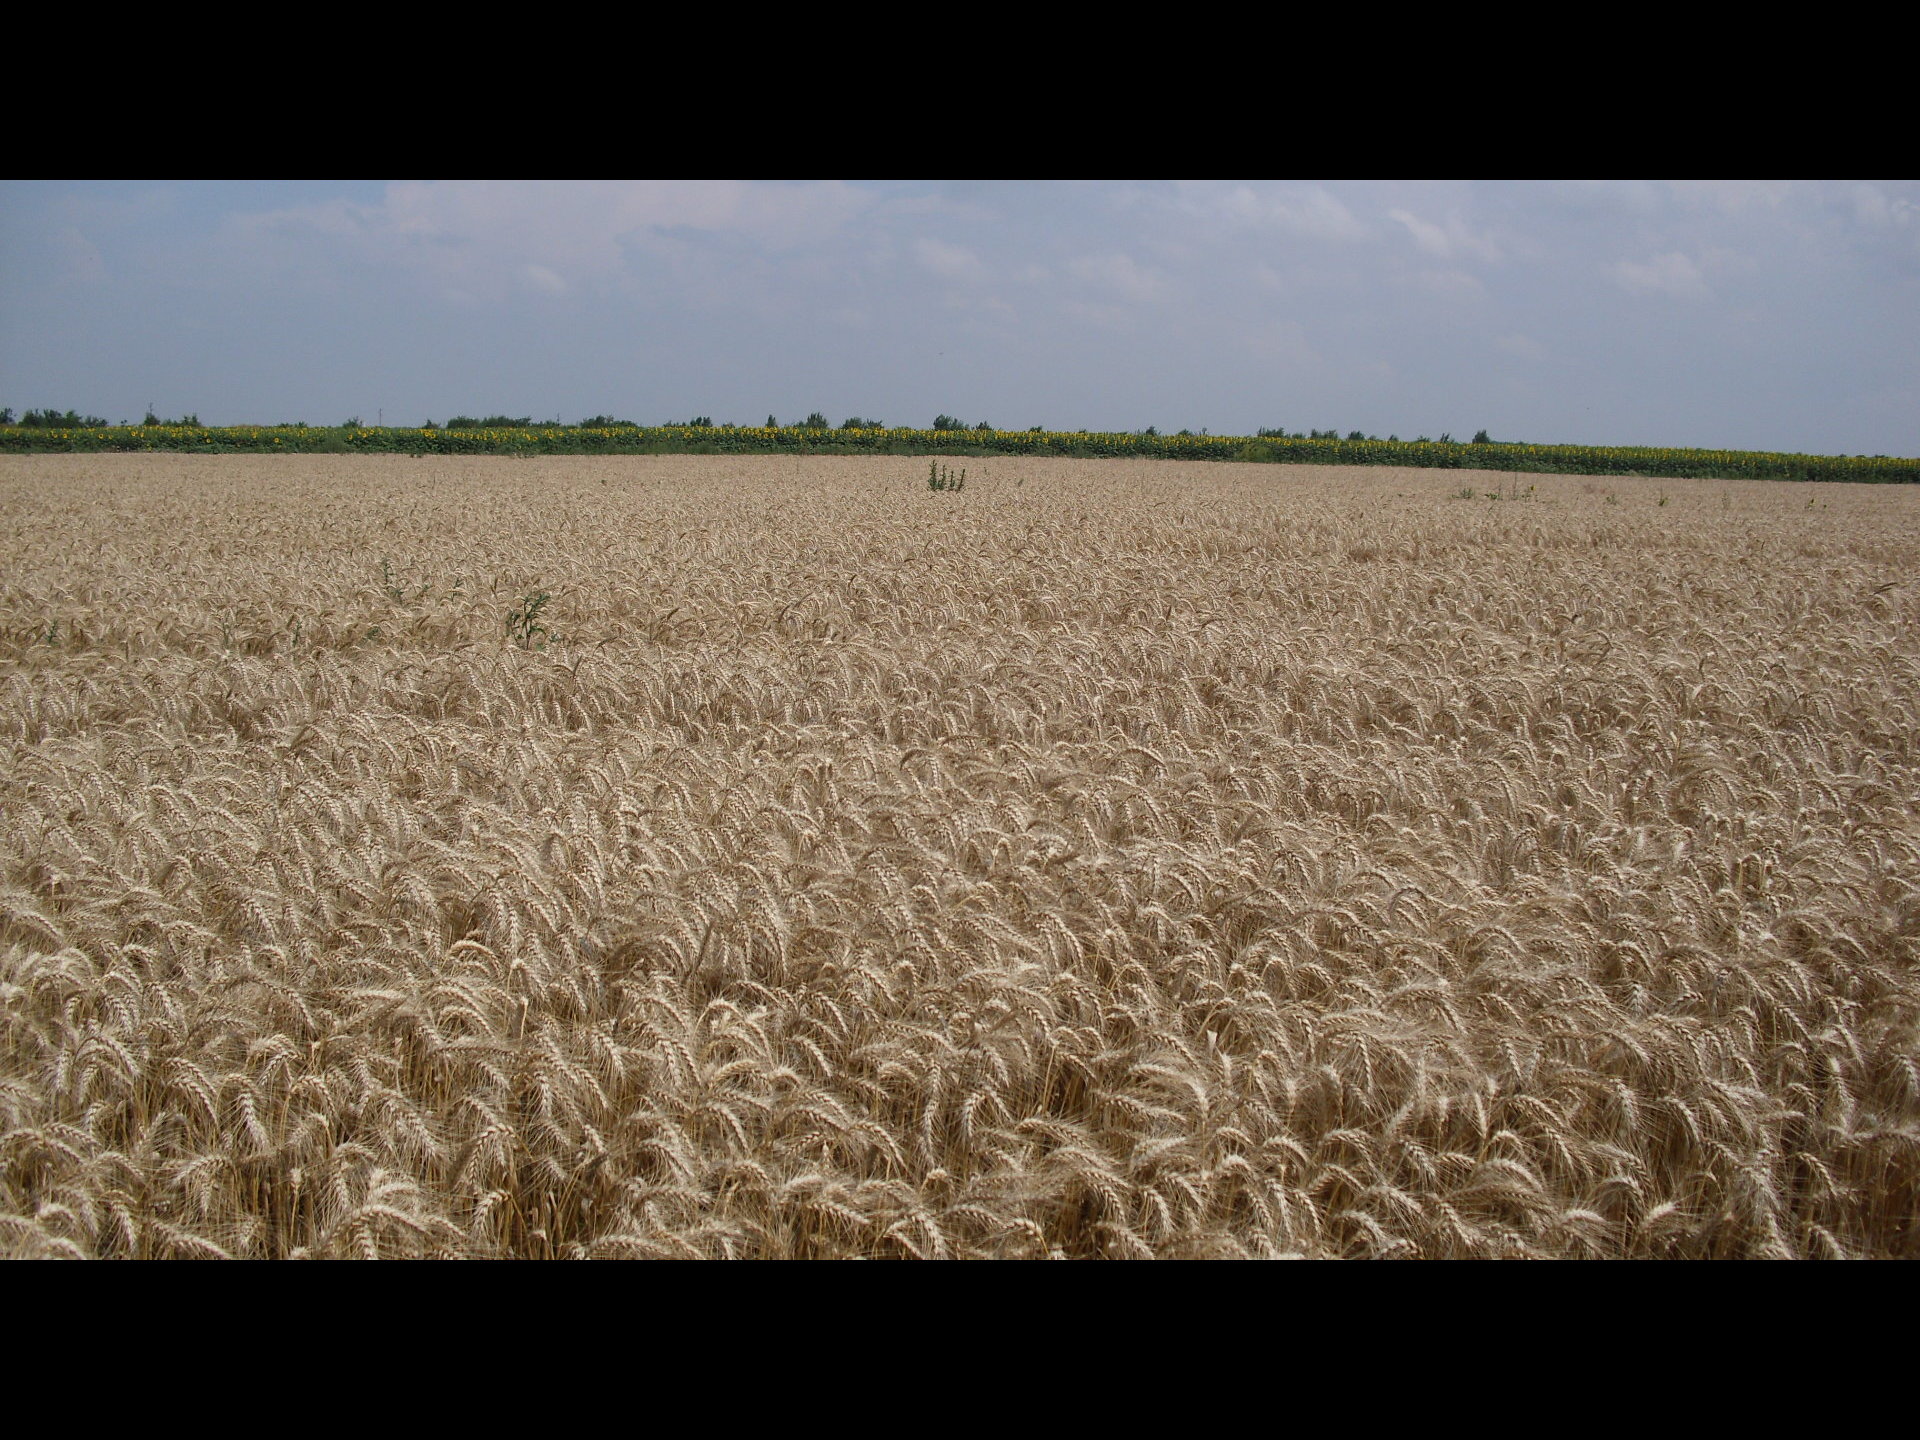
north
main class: Cropland
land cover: Sunflower
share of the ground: > 75 %
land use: Agriculture (excluding fallow land and kitchen gardens)
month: June
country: BG
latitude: 43.6788
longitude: 23.2529
